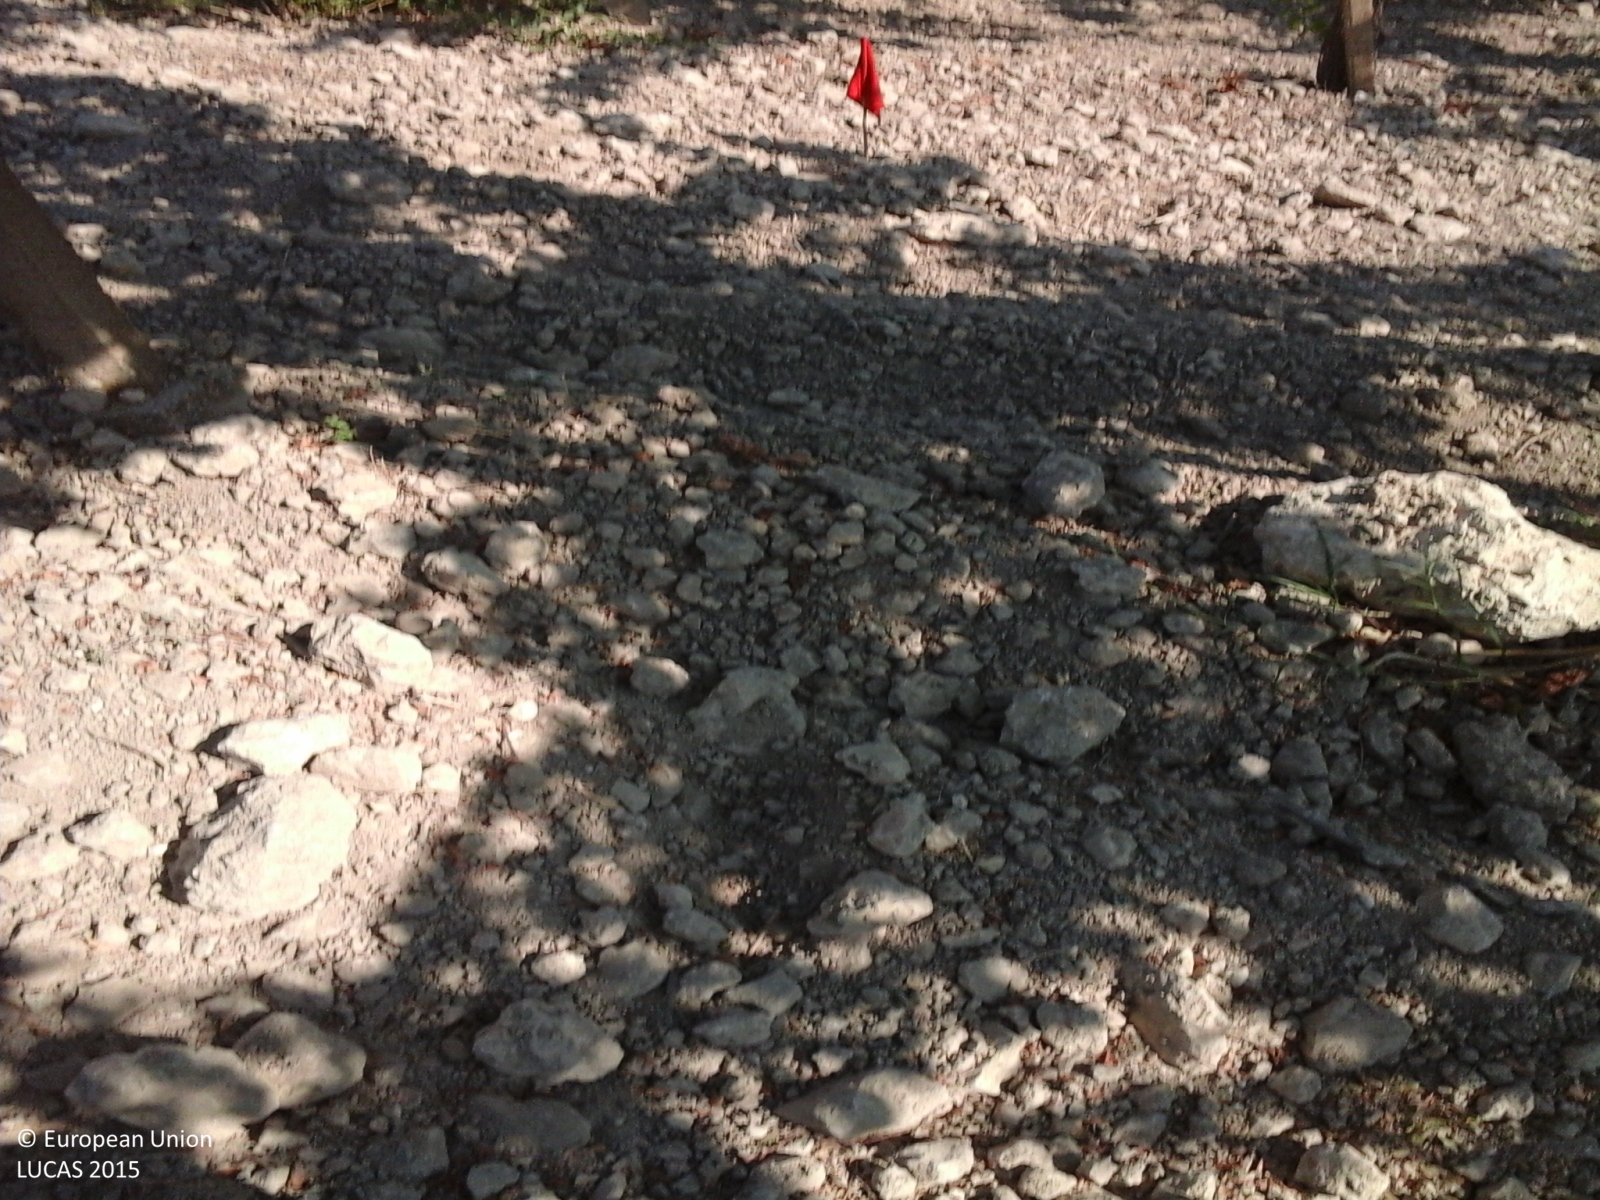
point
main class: Cropland
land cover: Vineyards
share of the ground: > 75 %
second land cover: Other bare soil
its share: > 75 %
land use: Agriculture (excluding fallow land and kitchen gardens)
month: July
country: IT
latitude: 37.2408
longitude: 14.1052
